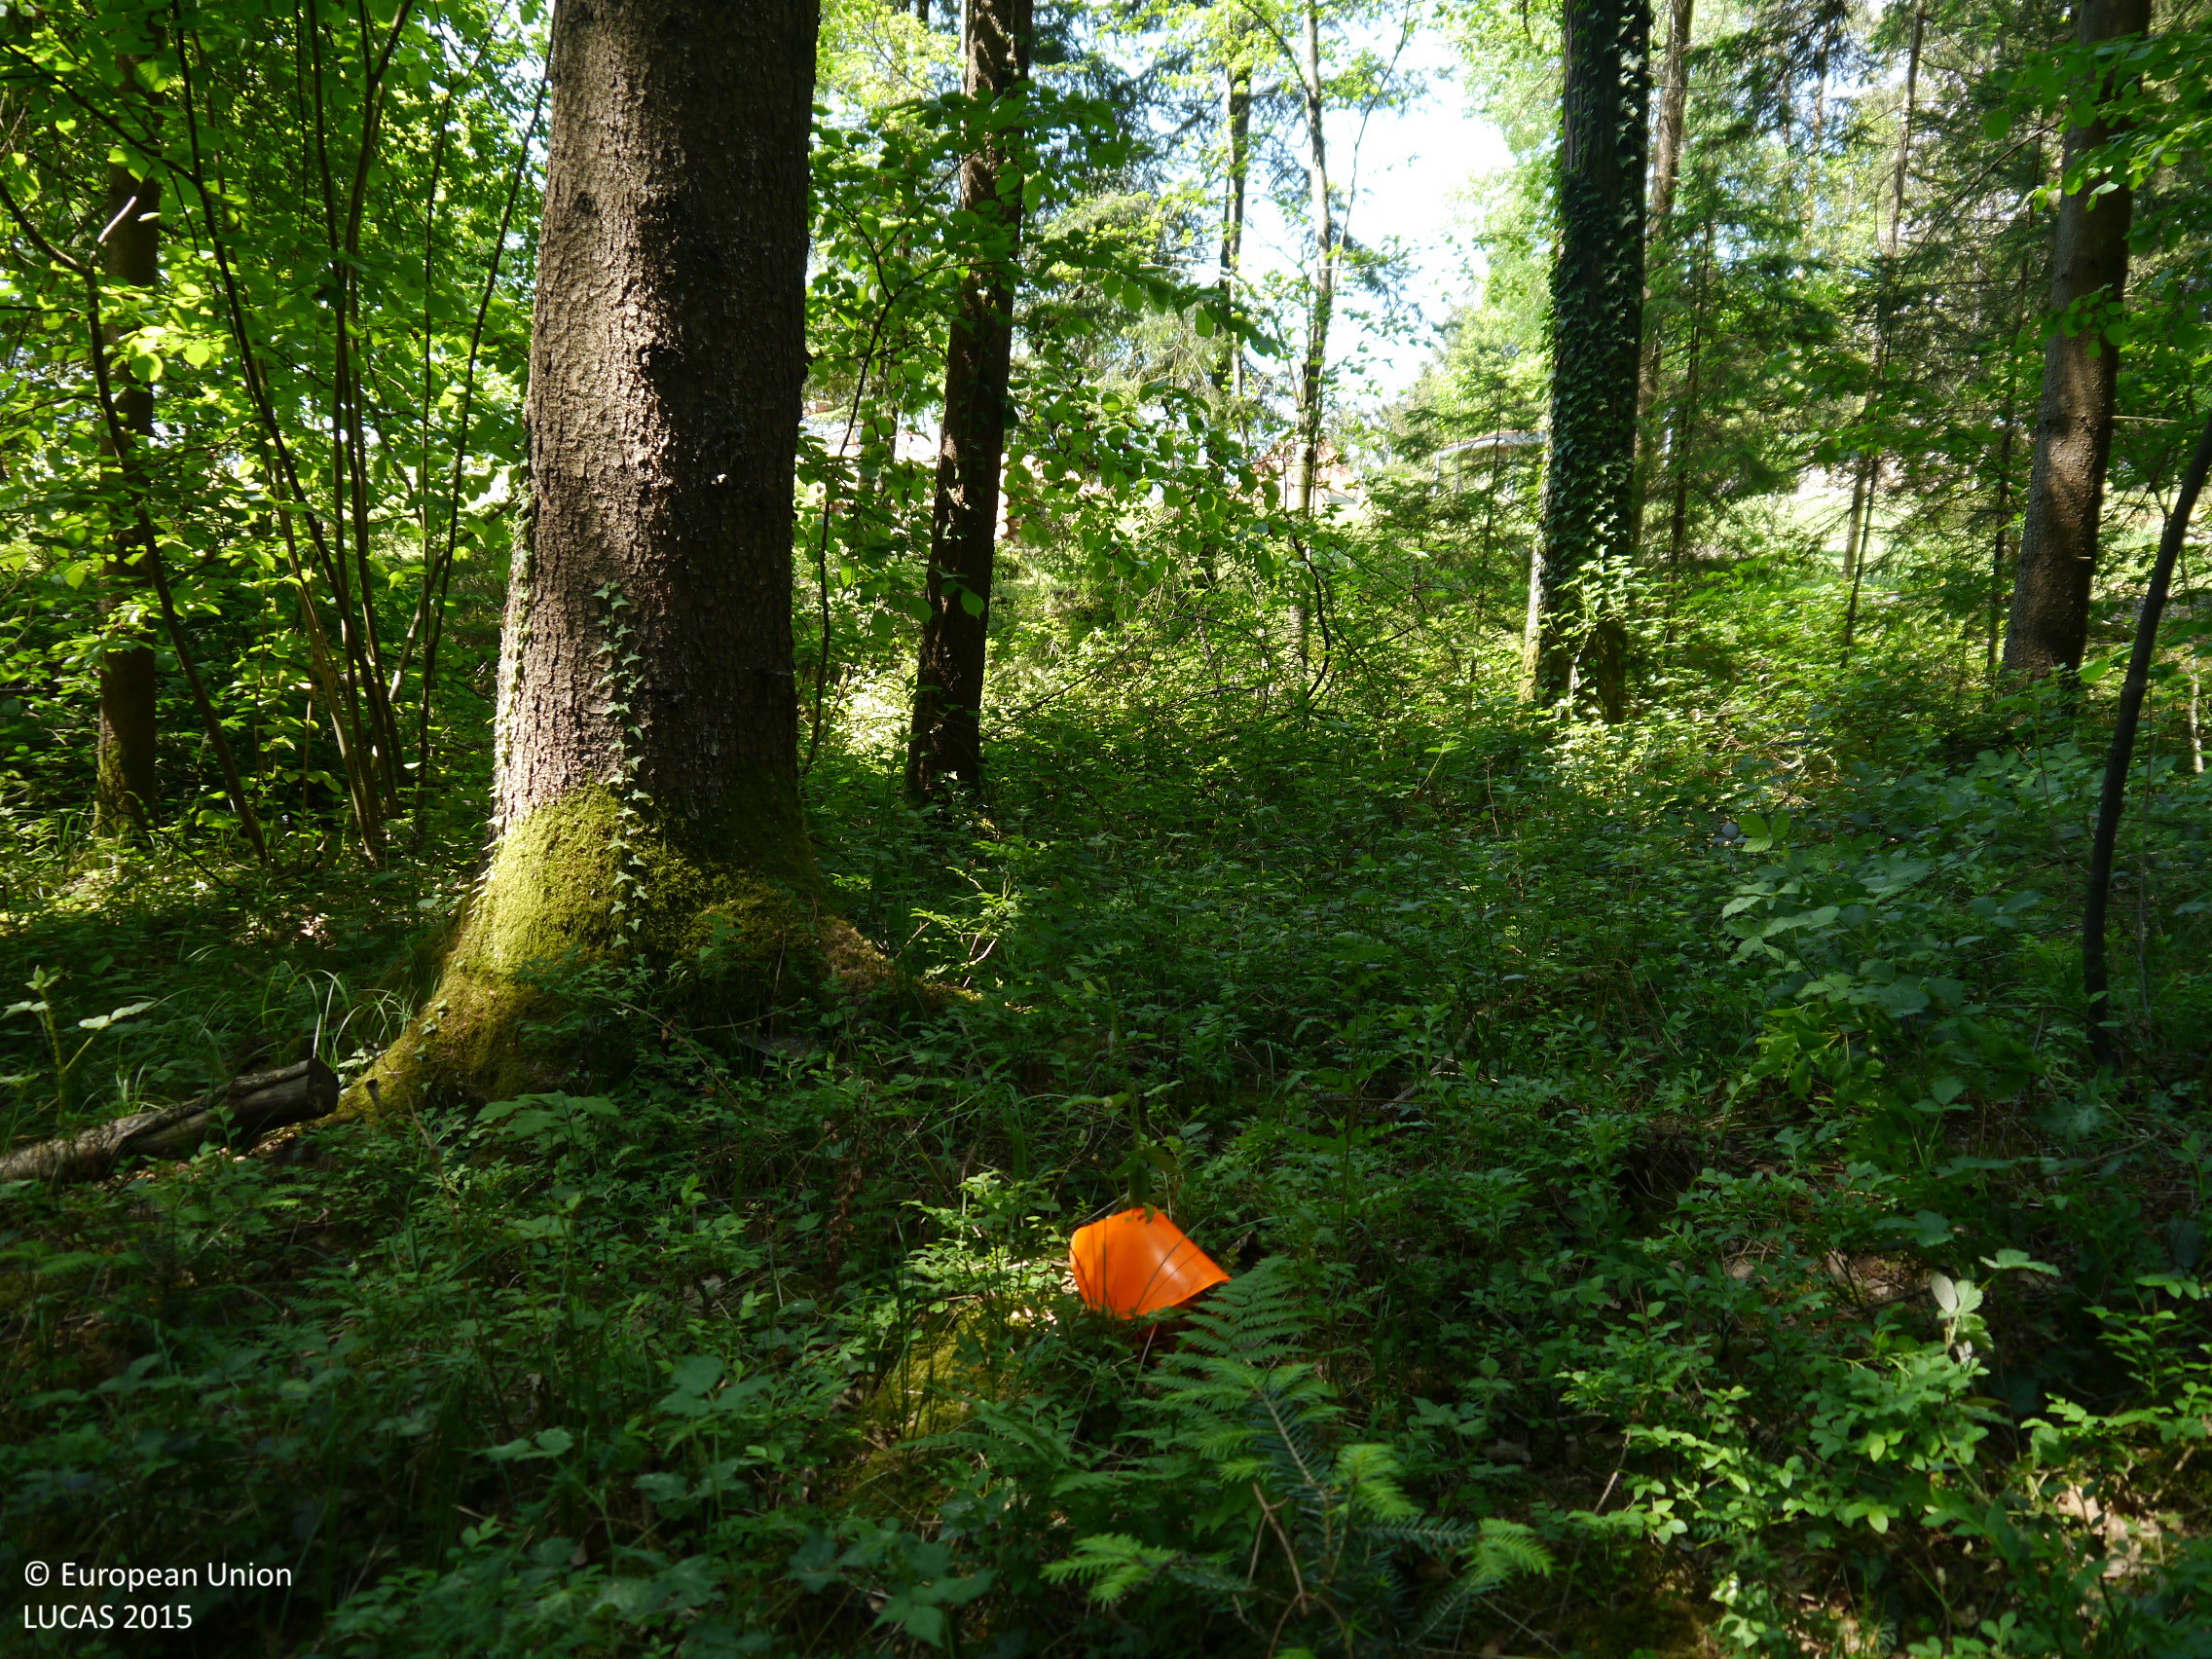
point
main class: Woodland
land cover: Spruce dominated coniferous woodland
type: hemiboreal forest and nemoral coniferous forest and mixed broadleaved-coniferous forest
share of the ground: > 75 %
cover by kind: coniferous forest trees 80 %, herbaceous plants 10 %, broadleaved forest trees 5 %, shrubs 5 %
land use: Forestry
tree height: > 5 m
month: May
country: AT
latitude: 46.9959
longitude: 15.2989
